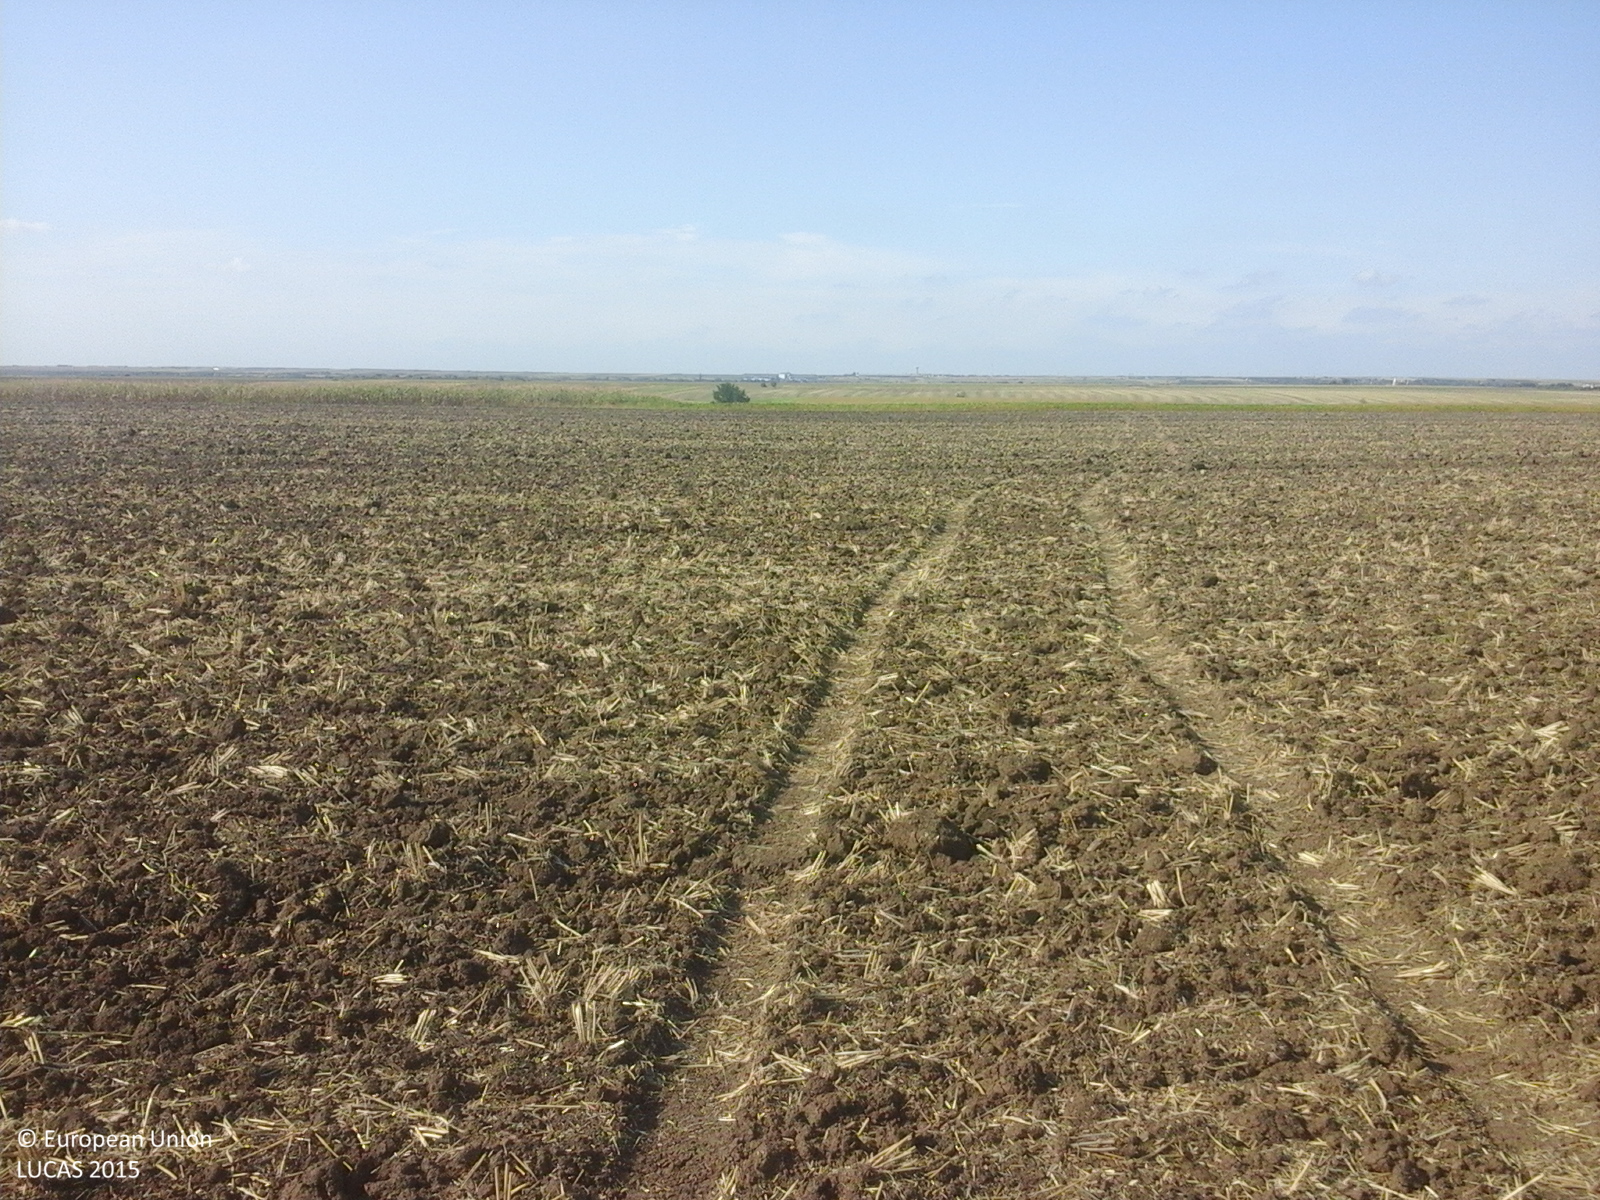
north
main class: Cropland
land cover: Common wheat
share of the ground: < 10 %
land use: Agriculture (excluding fallow land and kitchen gardens)
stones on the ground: < 10 %
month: August
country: RO
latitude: 45.3928
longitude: 21.4117
